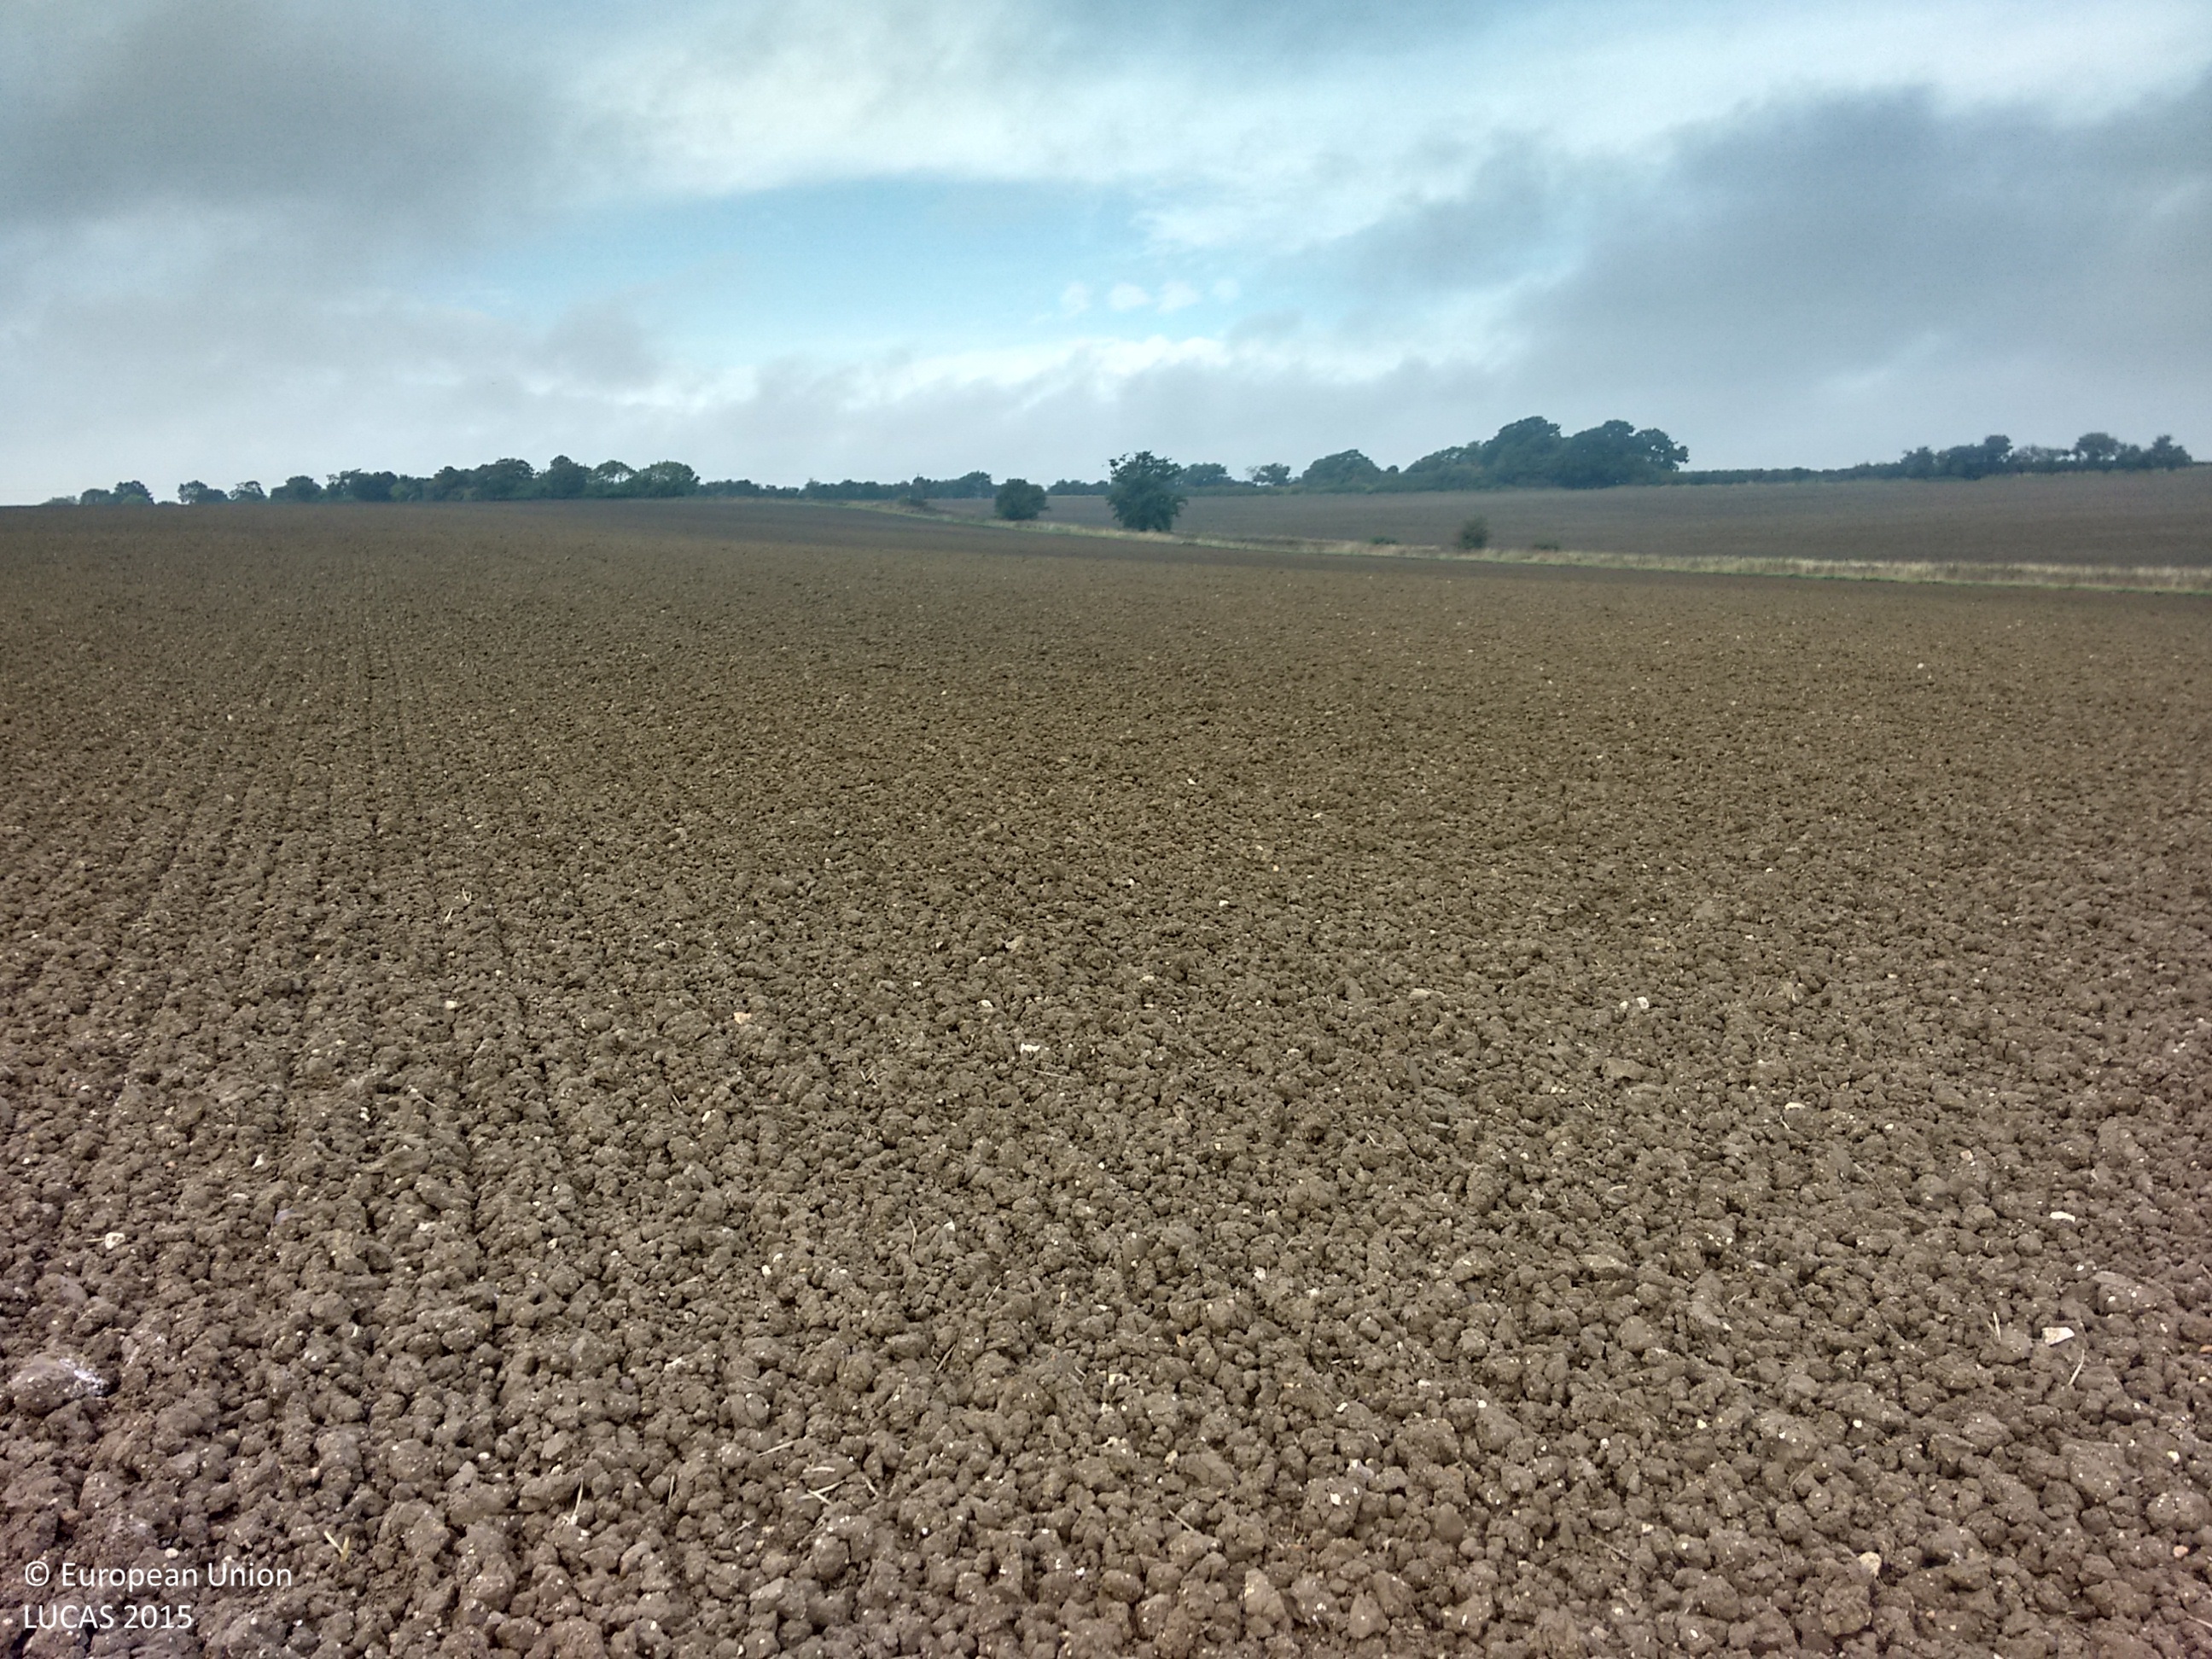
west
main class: Cropland
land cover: Common wheat
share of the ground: < 10 %
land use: Agriculture (excluding fallow land and kitchen gardens)
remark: Harvested field
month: October
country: GB
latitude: 52.0698
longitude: 0.2981
